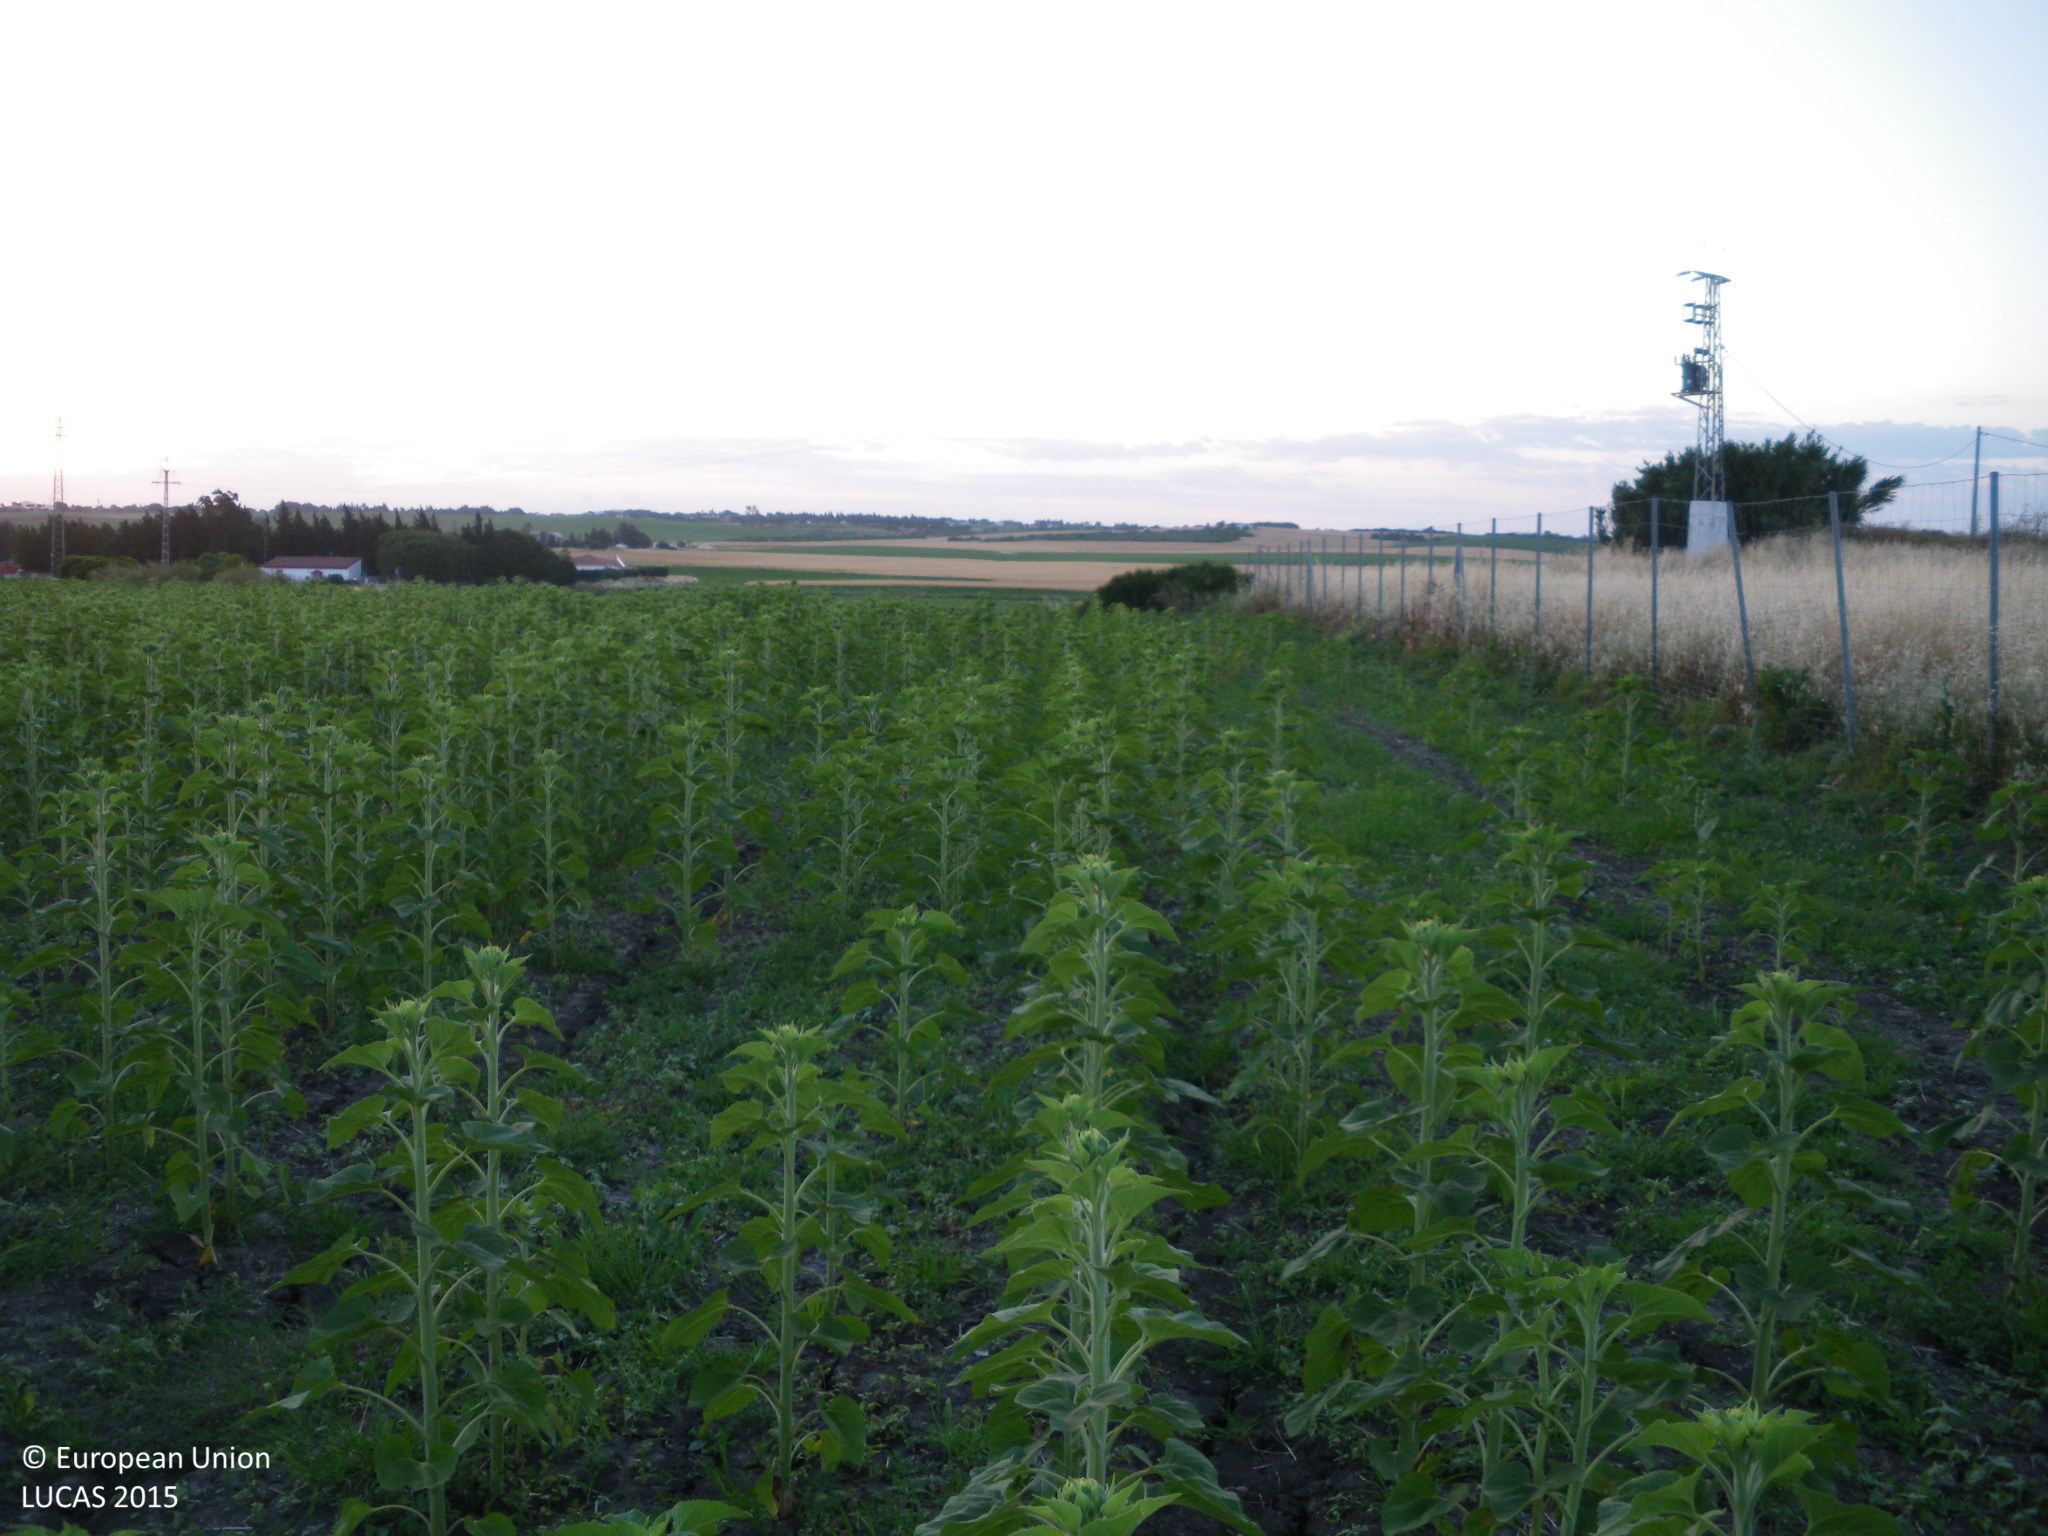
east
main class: Cropland
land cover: Sunflower
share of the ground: 25 - 50 %
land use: Agriculture (excluding fallow land and kitchen gardens)
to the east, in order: Sunflower; Grass margins; Spontaneously vegetated surfaces; Electric lines; Spontaneously vegetated surfaces; Grass margins; Sunflower; Electric lines; Sunflower
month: May
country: ES
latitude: 36.3642
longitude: -6.1097
